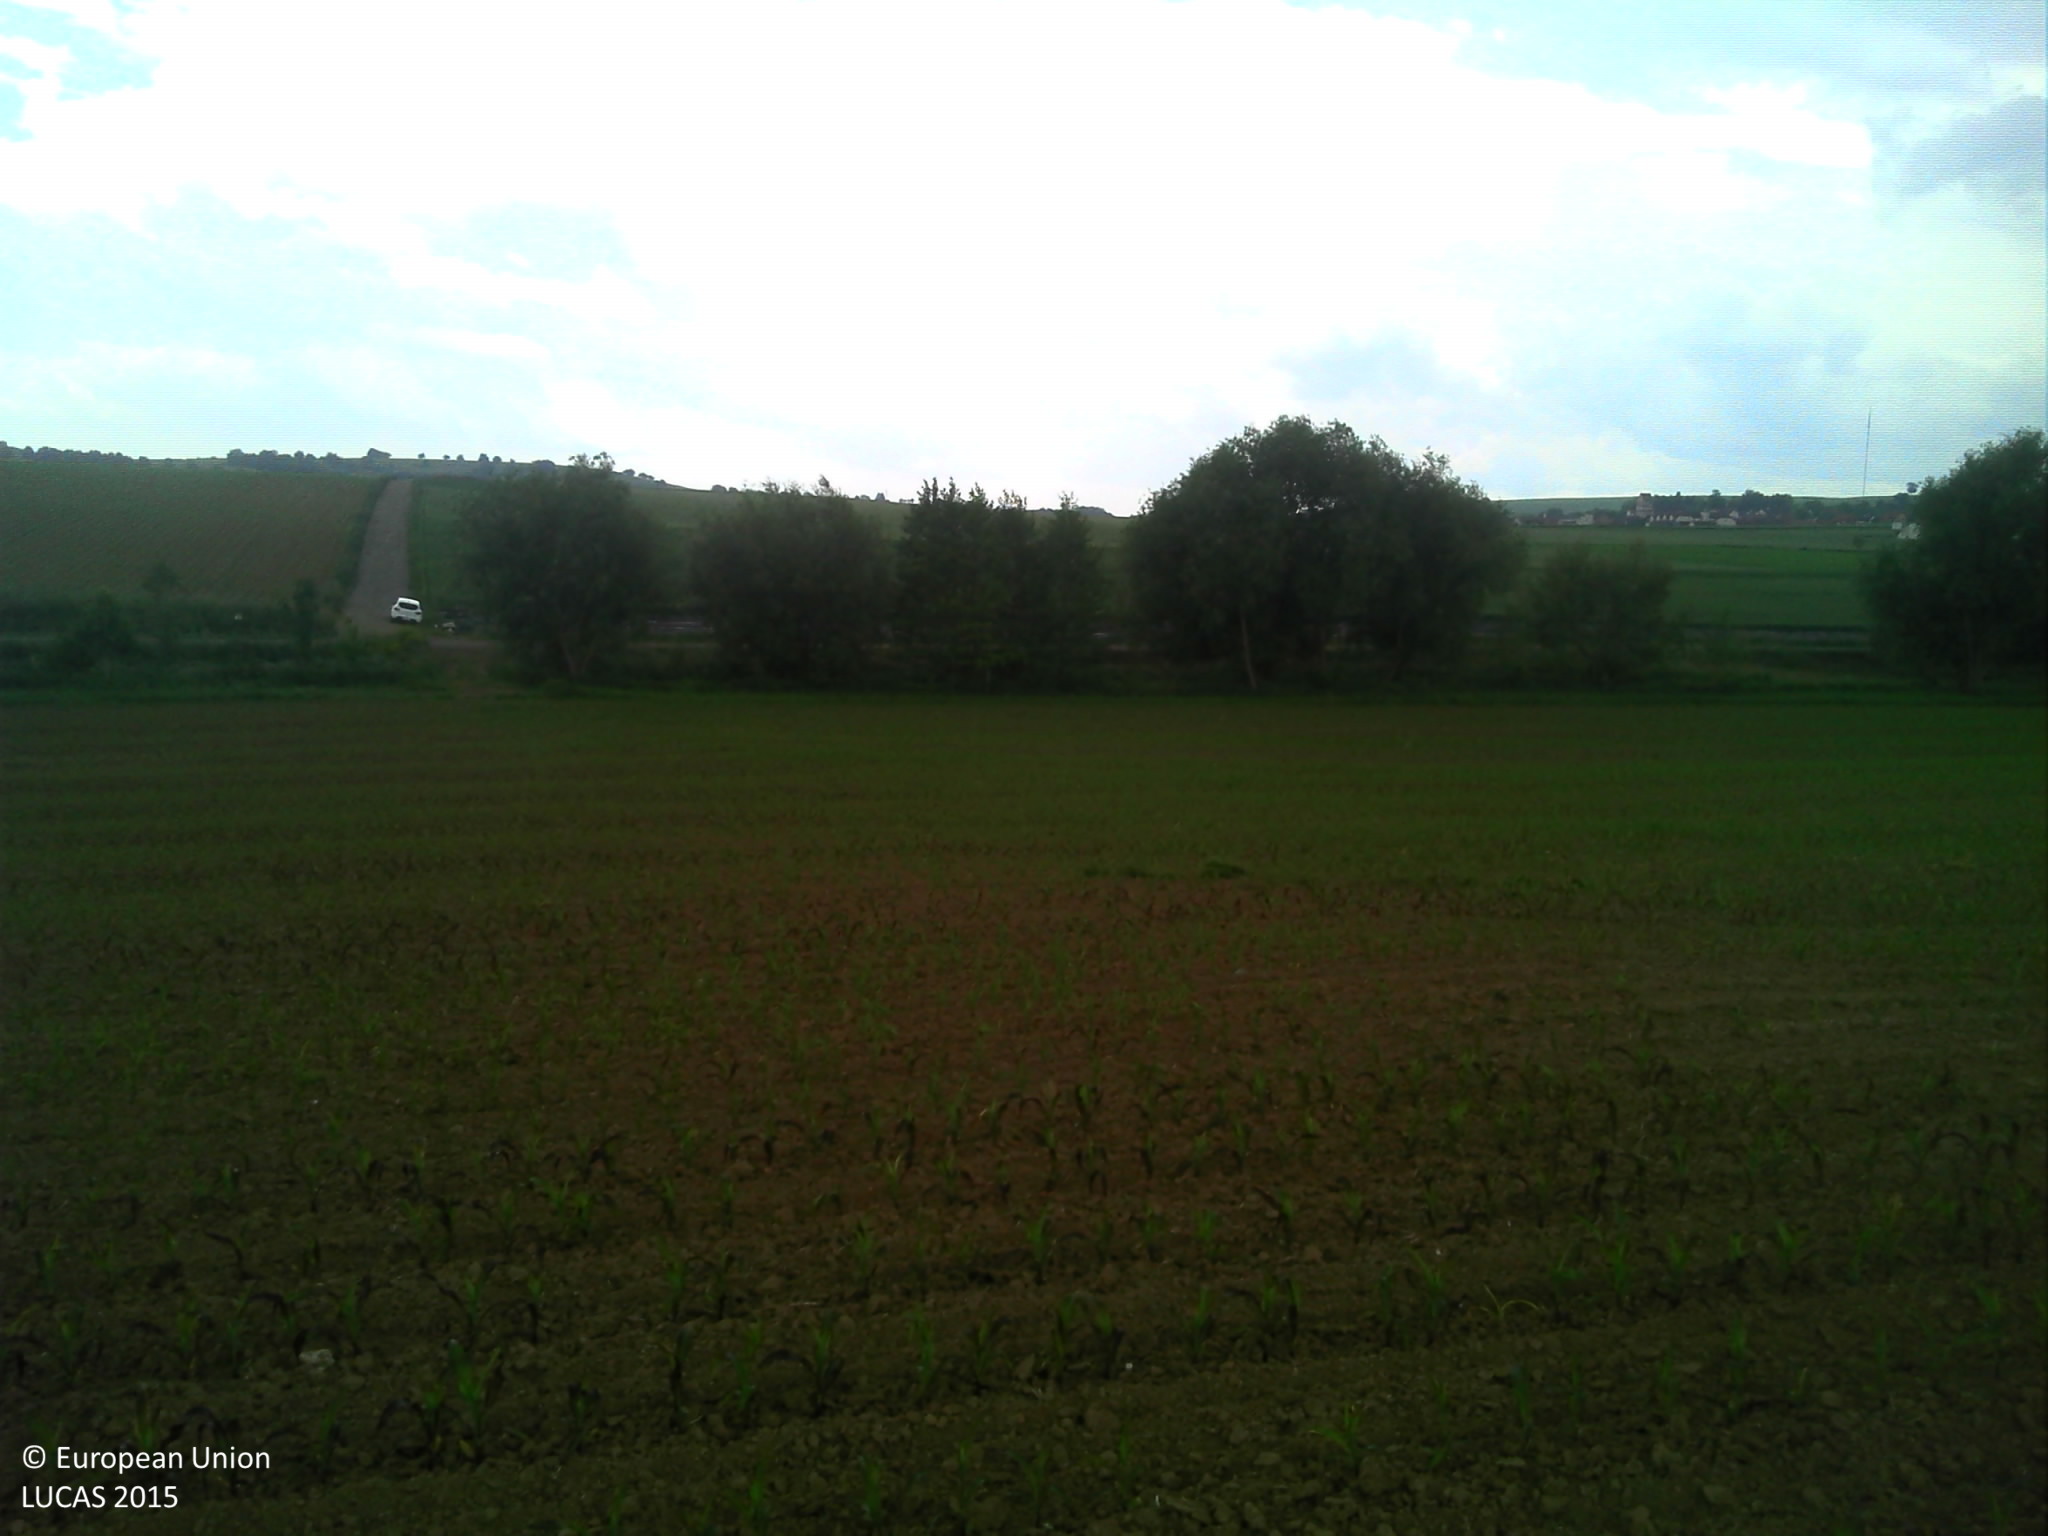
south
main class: Cropland
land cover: Maize
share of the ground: 10 - 25 %
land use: Agriculture (excluding fallow land and kitchen gardens)
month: May
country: FR
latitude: 48.6816
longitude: 7.5152
